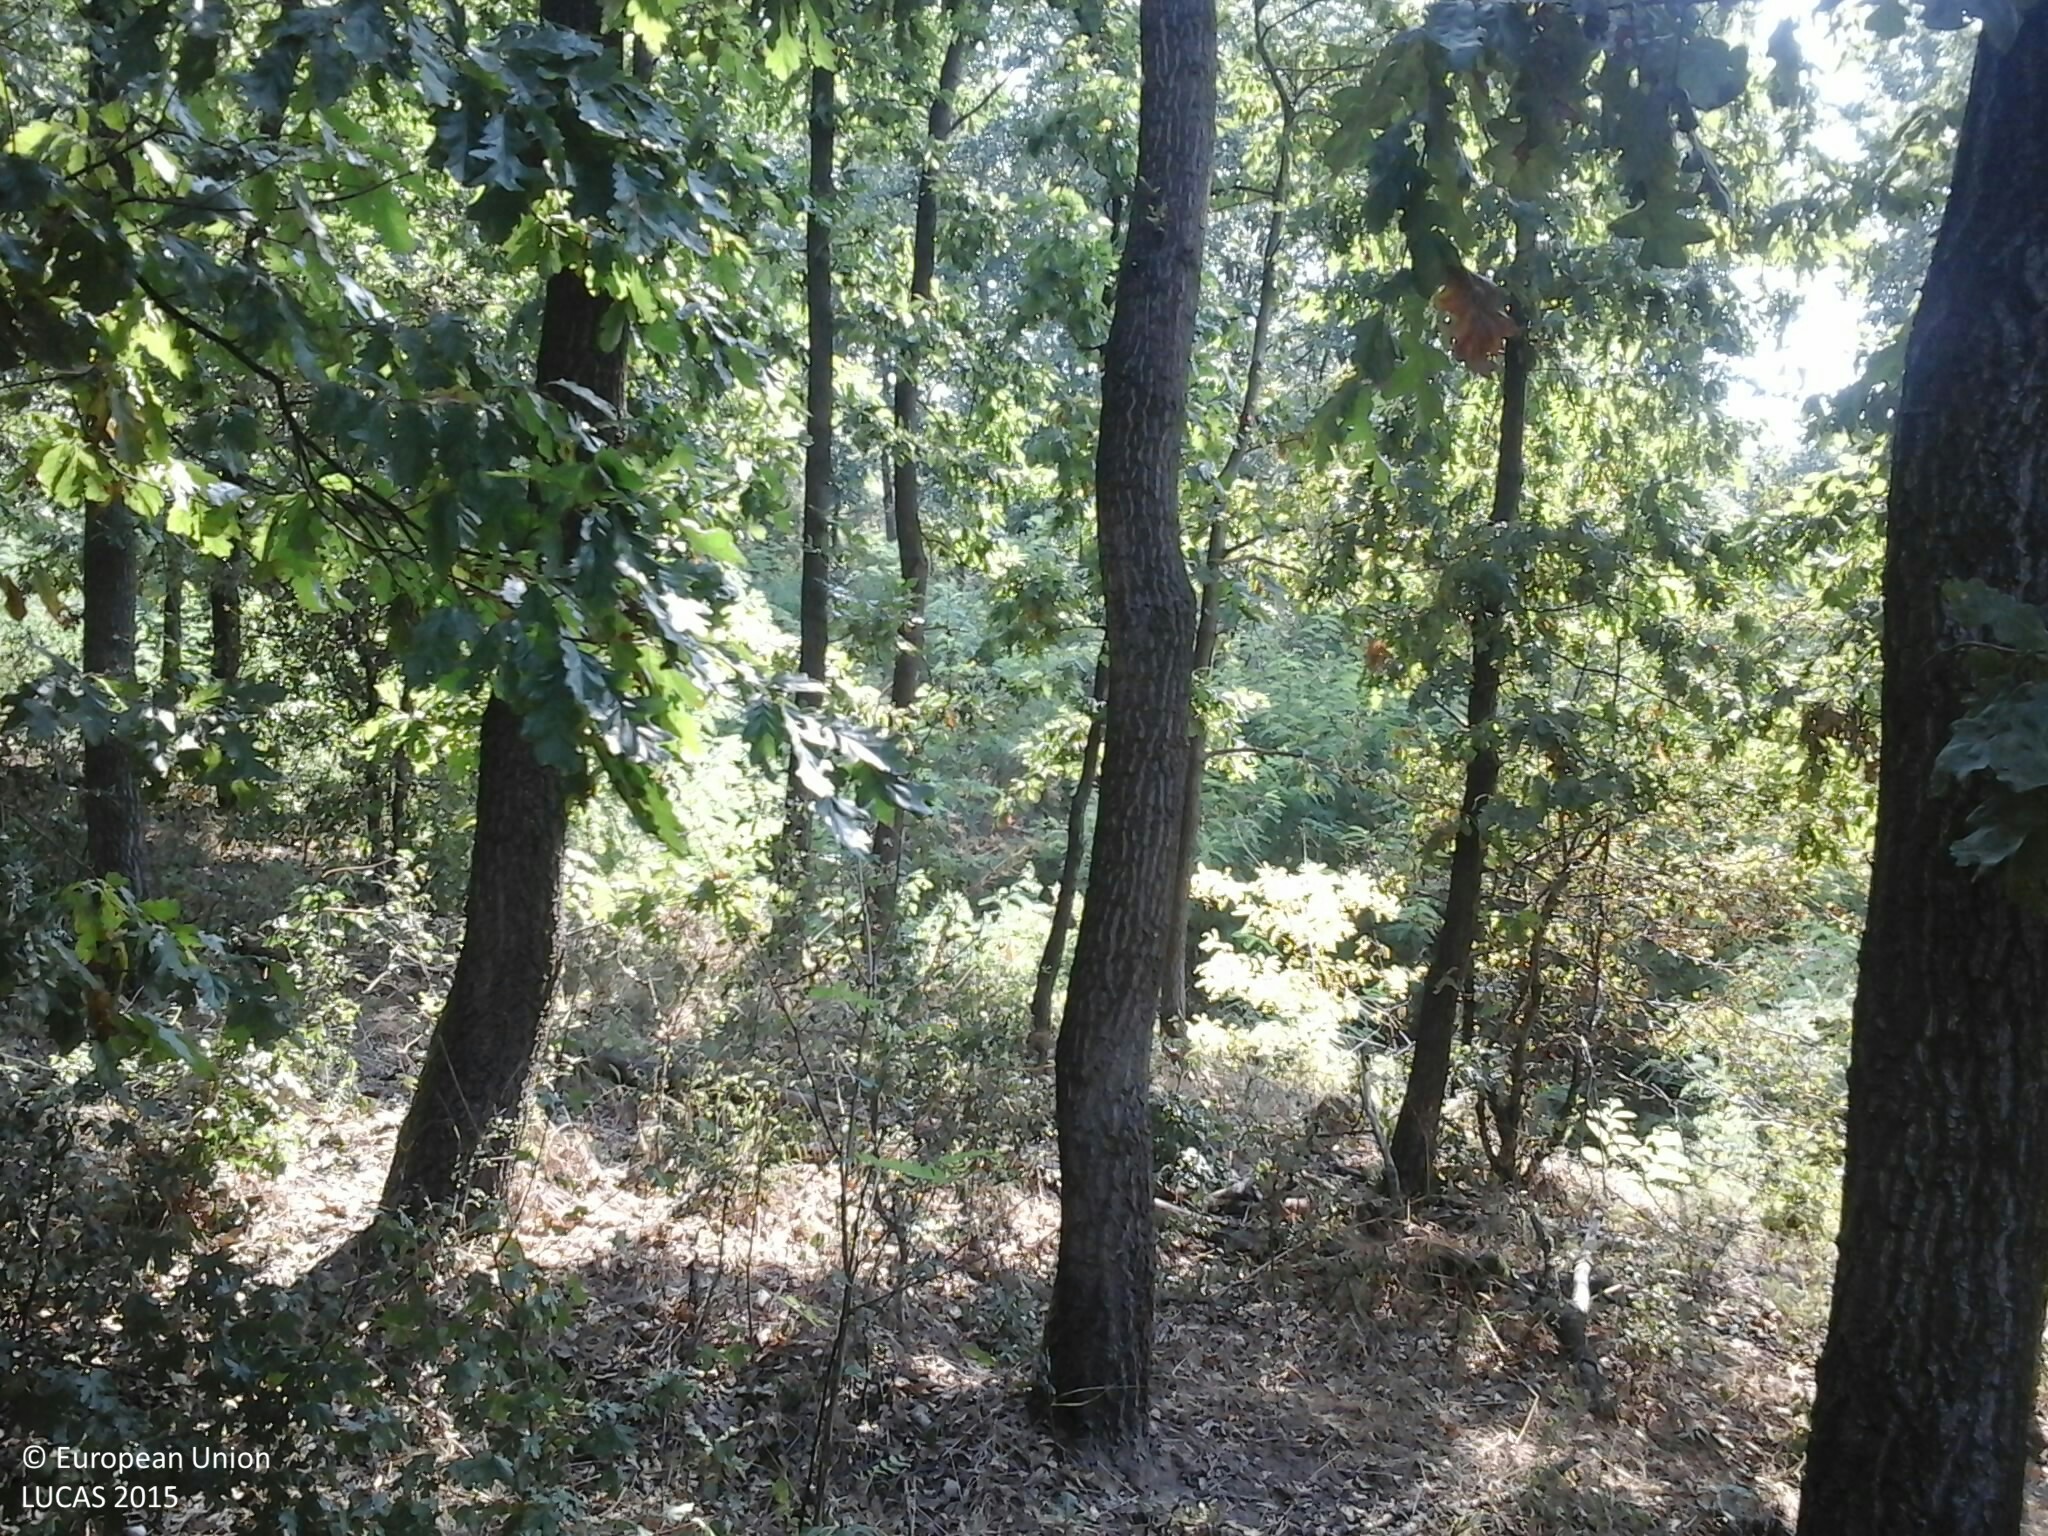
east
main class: Woodland
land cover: Broadleaved woodland
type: thermophilous deciduous forest
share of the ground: > 75 %
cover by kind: broadleaved forest trees 80 %, shrubs 15 %, herbaceous plants 5 %
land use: Forestry
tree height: > 5 m
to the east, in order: Broadleaved woodland
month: August
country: HU
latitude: 47.9118
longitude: 19.1855
